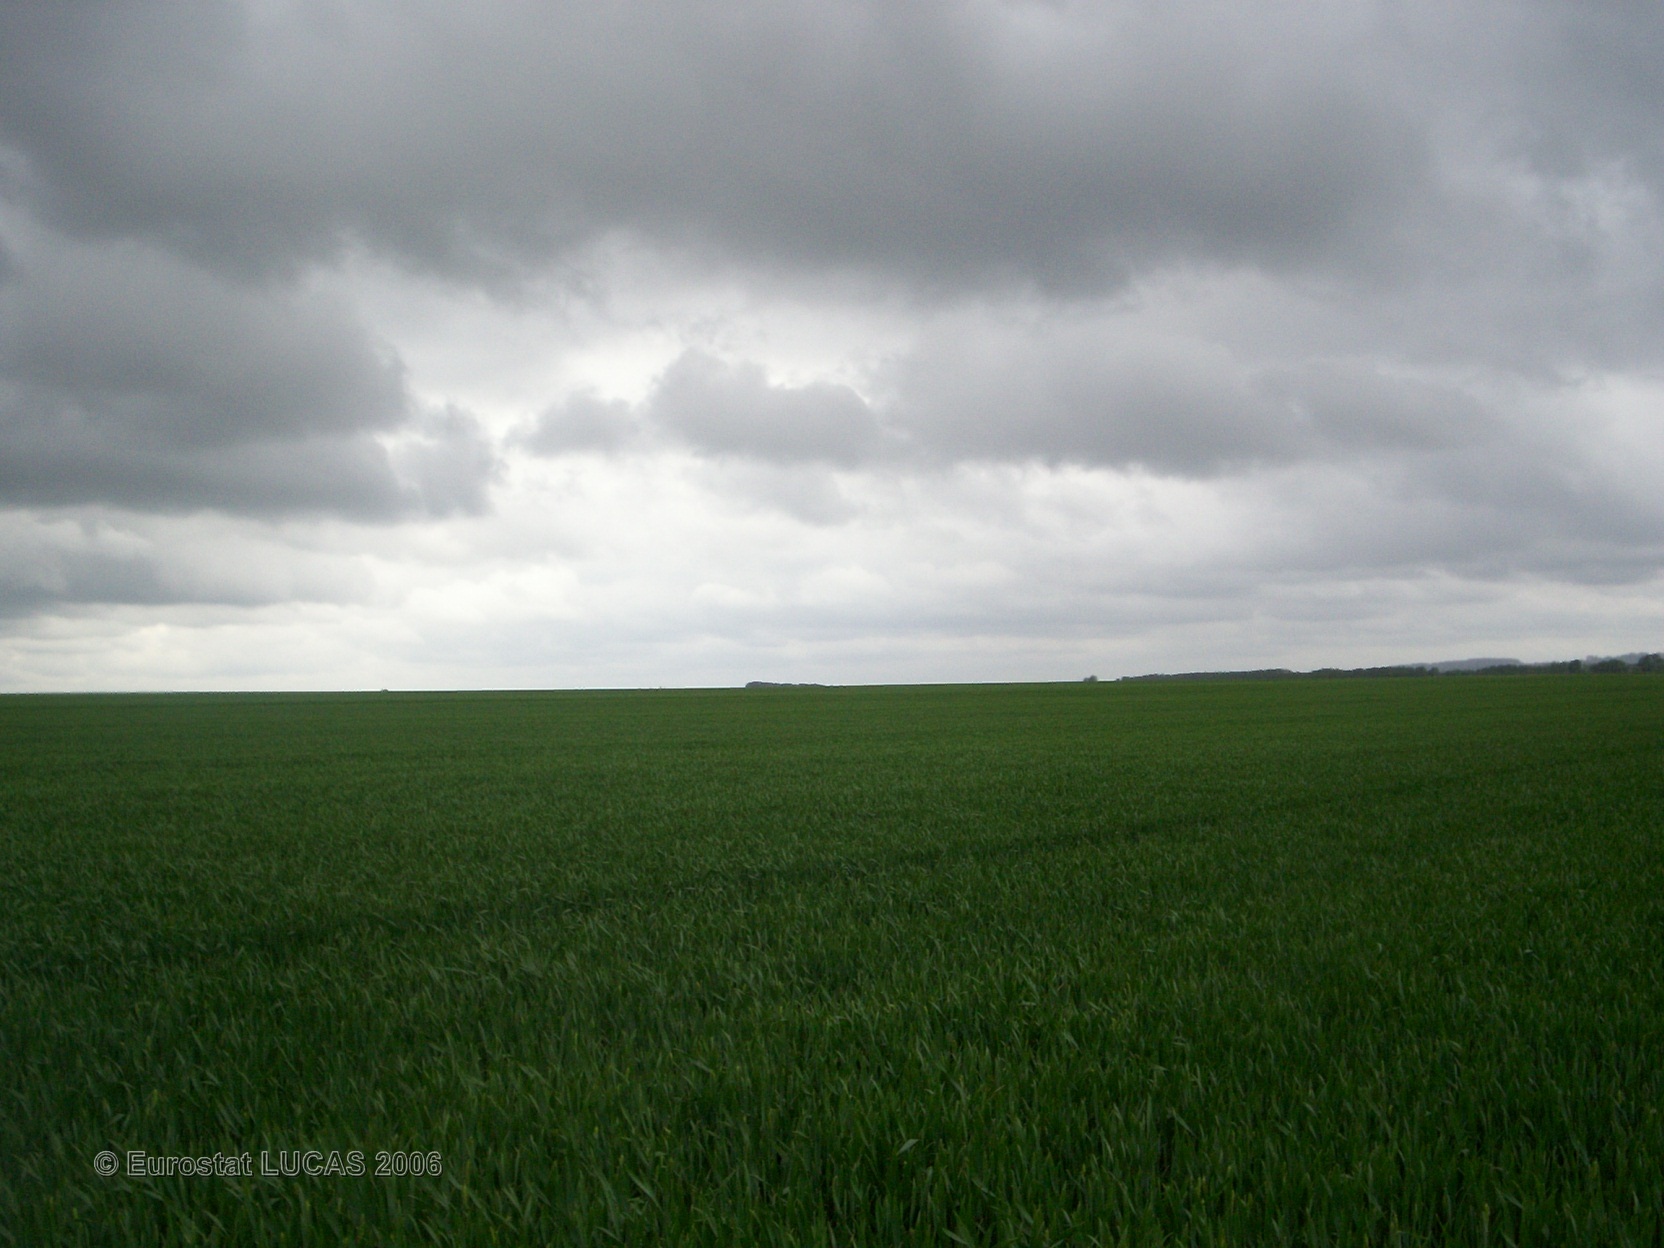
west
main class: Cropland
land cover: Common wheat
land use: Agriculture (excluding fallow land and kitchen gardens)
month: May
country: FR
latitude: 49.2276
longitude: 2.6978
